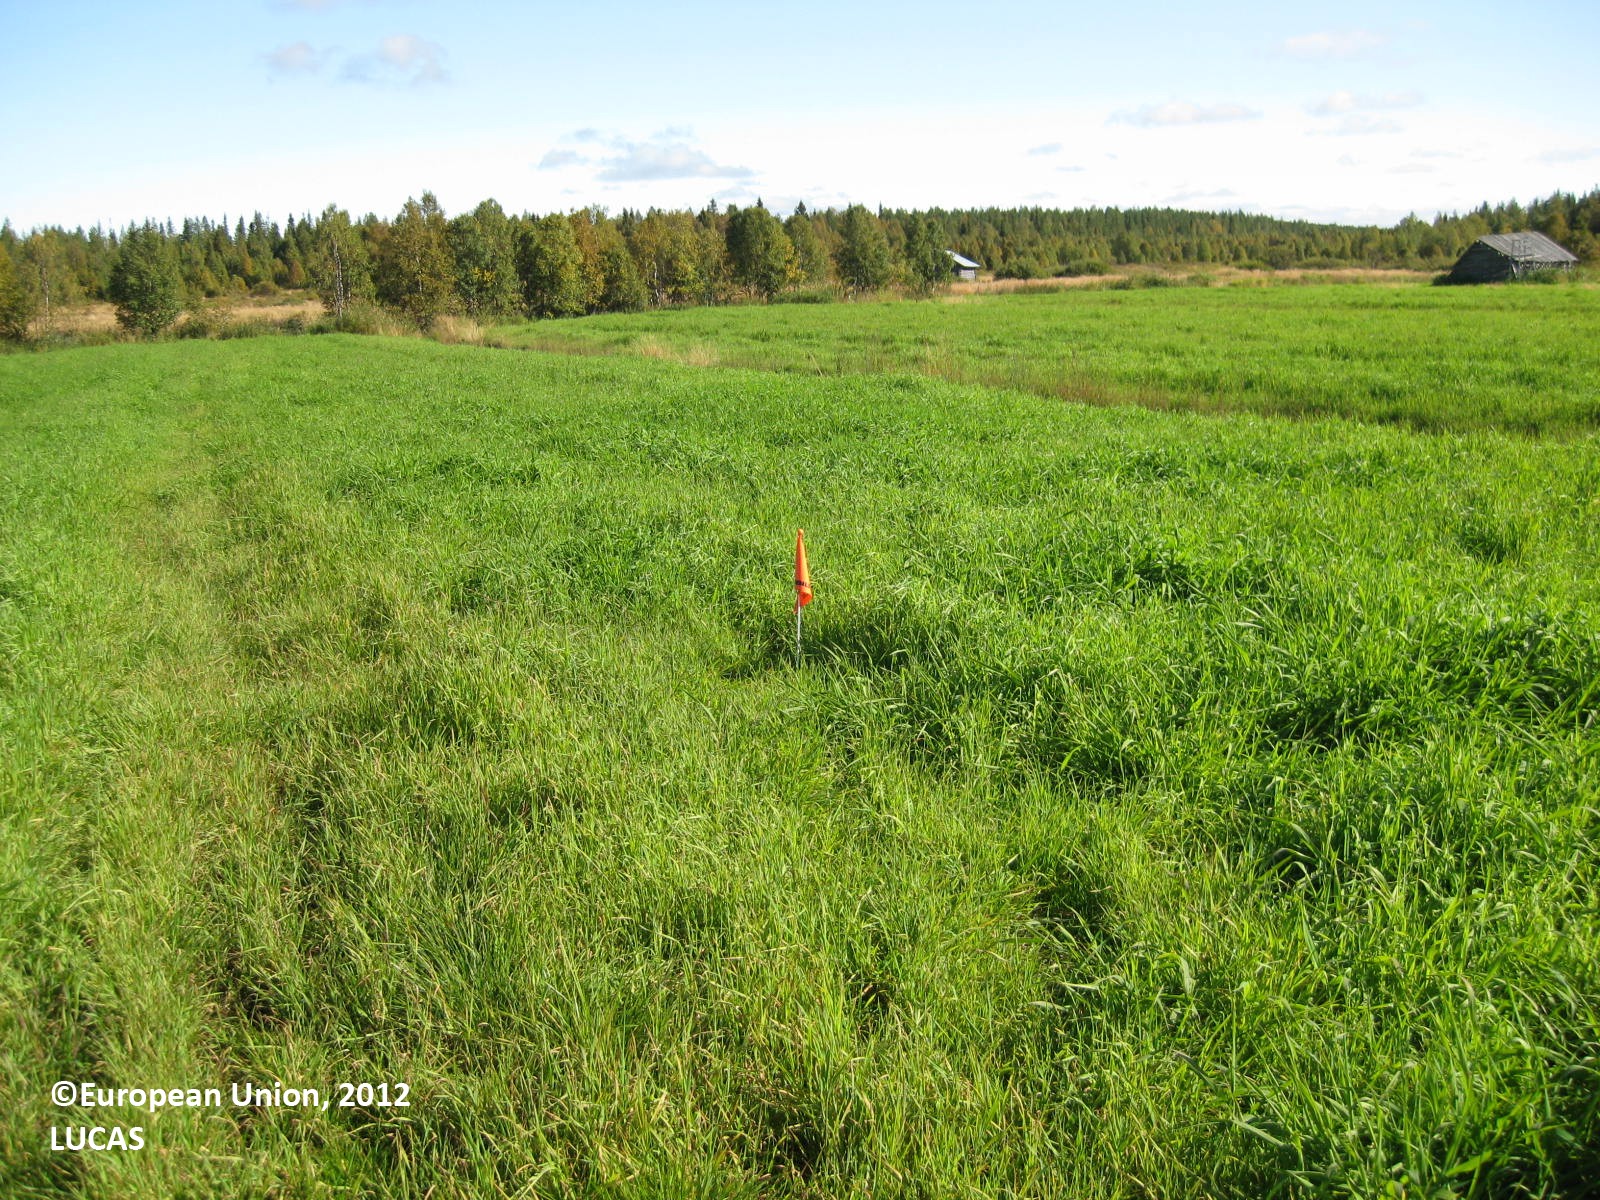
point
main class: Cropland
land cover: Temporary grasslands
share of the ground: > 75 %
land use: Agriculture (excluding fallow land and kitchen gardens)
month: August
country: FI
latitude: 66.0268
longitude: 29.7644
